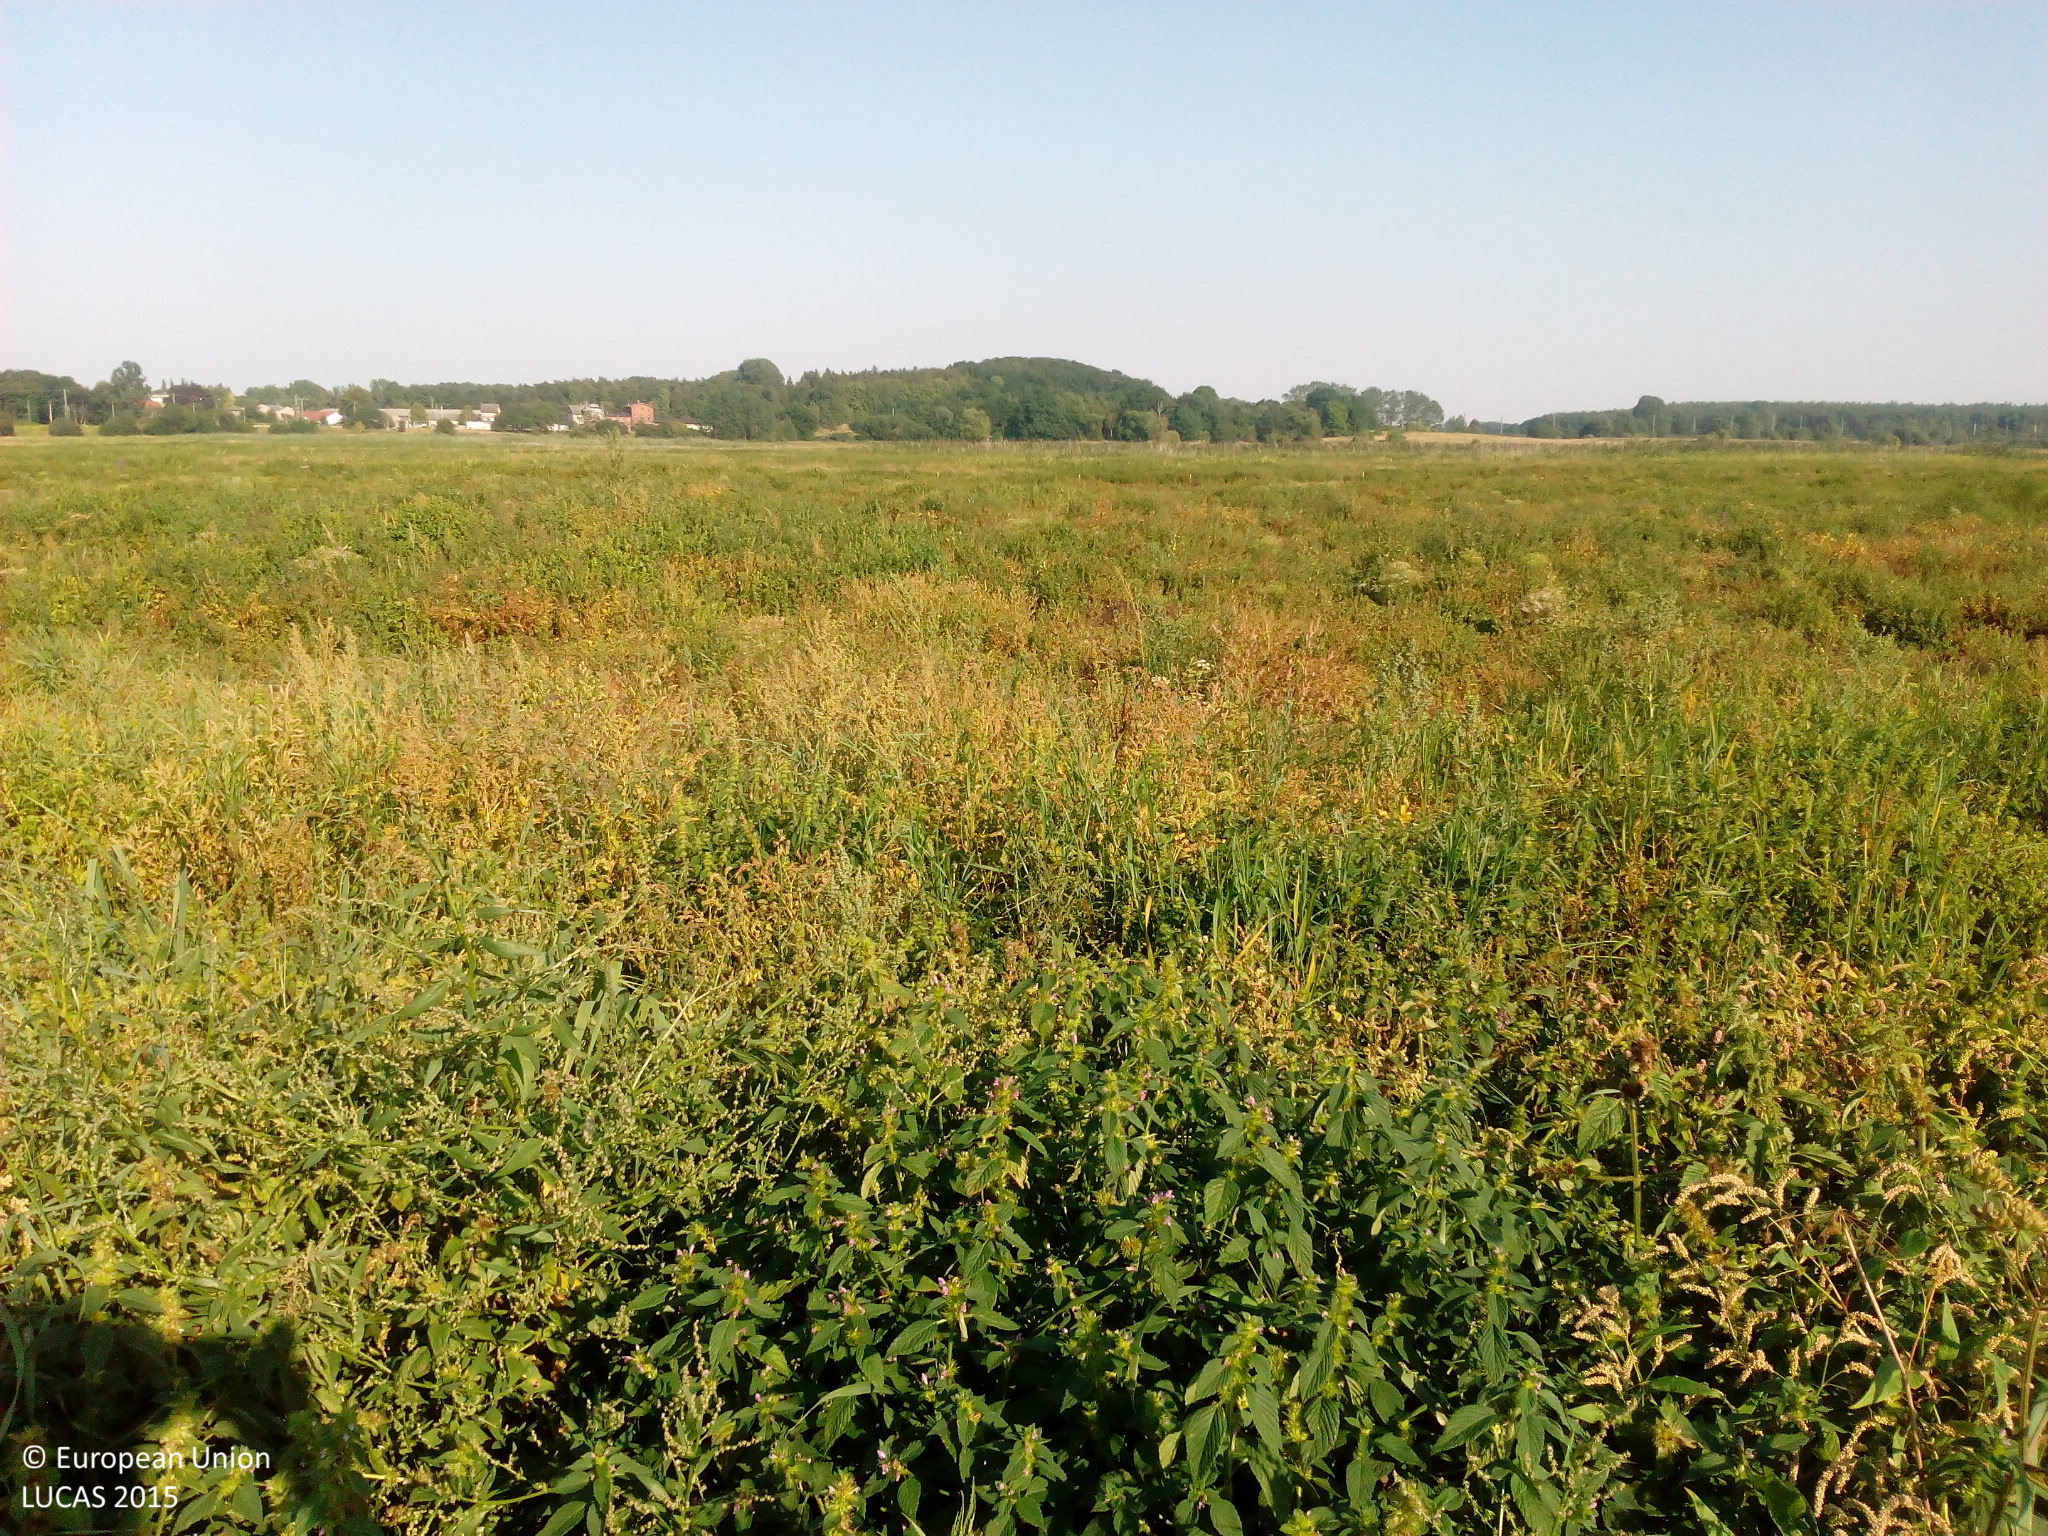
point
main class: Grassland
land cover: Spontaneously vegetated surfaces
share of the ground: > 75 %
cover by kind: herbaceous plants 100 %
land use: Semi-natural and natural areas not in use
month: August
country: DE
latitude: 53.9190
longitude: 12.3287
